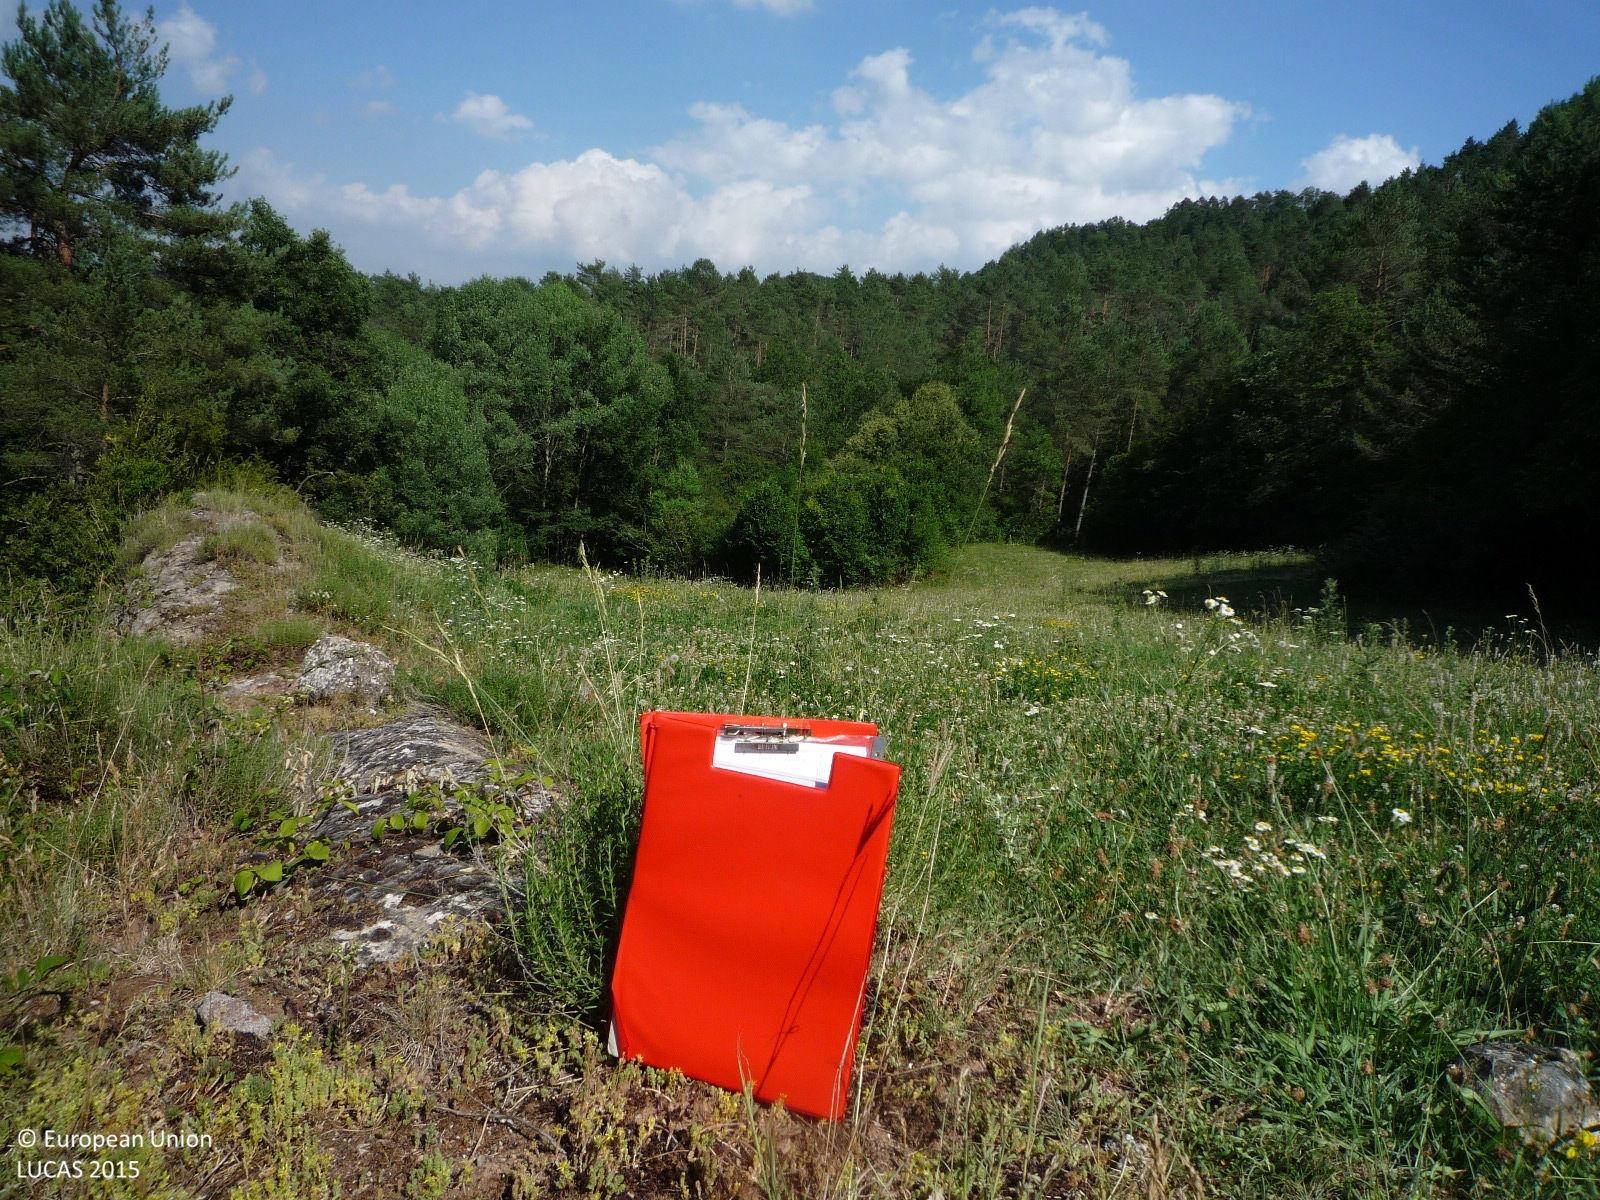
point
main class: Grassland
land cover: Grassland without tree/shrub cover
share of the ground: > 75 %
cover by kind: herbaceous plants 100 %
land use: Agriculture (excluding fallow land and kitchen gardens)
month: July
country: ES
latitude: 42.1484
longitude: 2.1356
